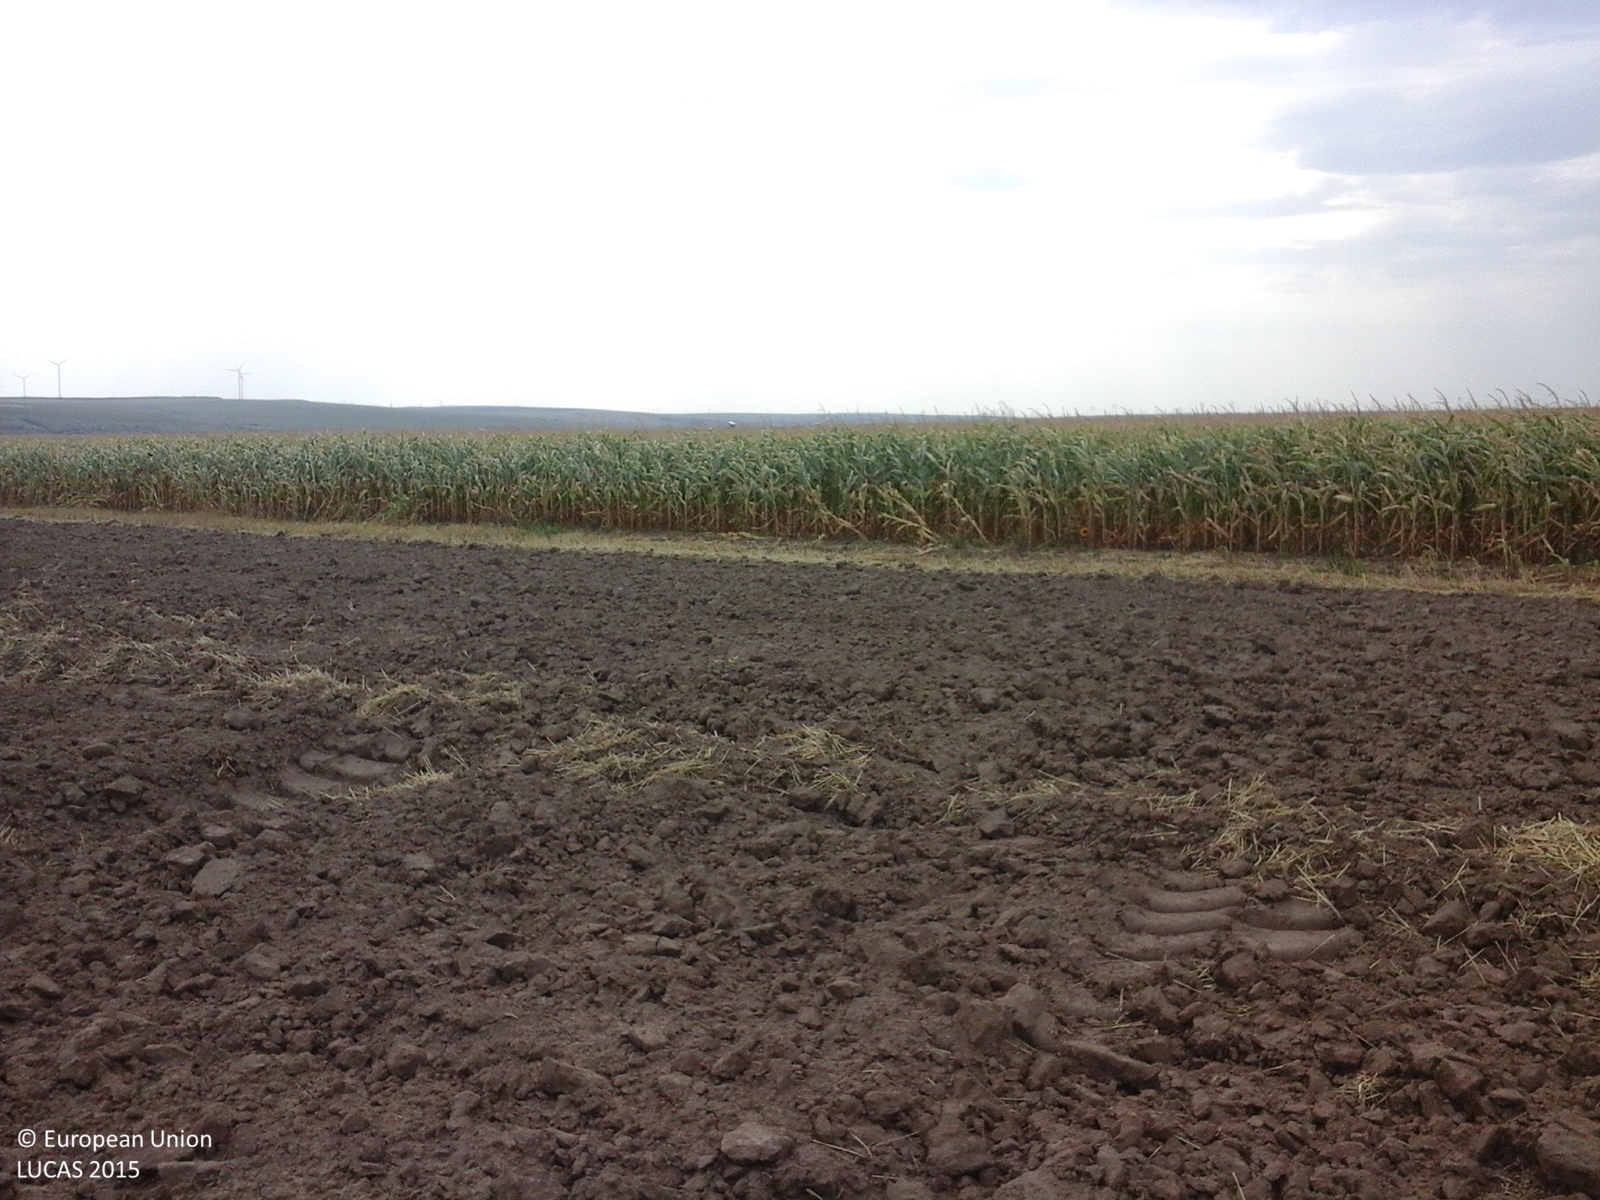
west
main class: Cropland
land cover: Common wheat
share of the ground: < 10 %
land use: Agriculture (excluding fallow land and kitchen gardens)
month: August
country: RO
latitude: 44.3545
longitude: 28.1645
